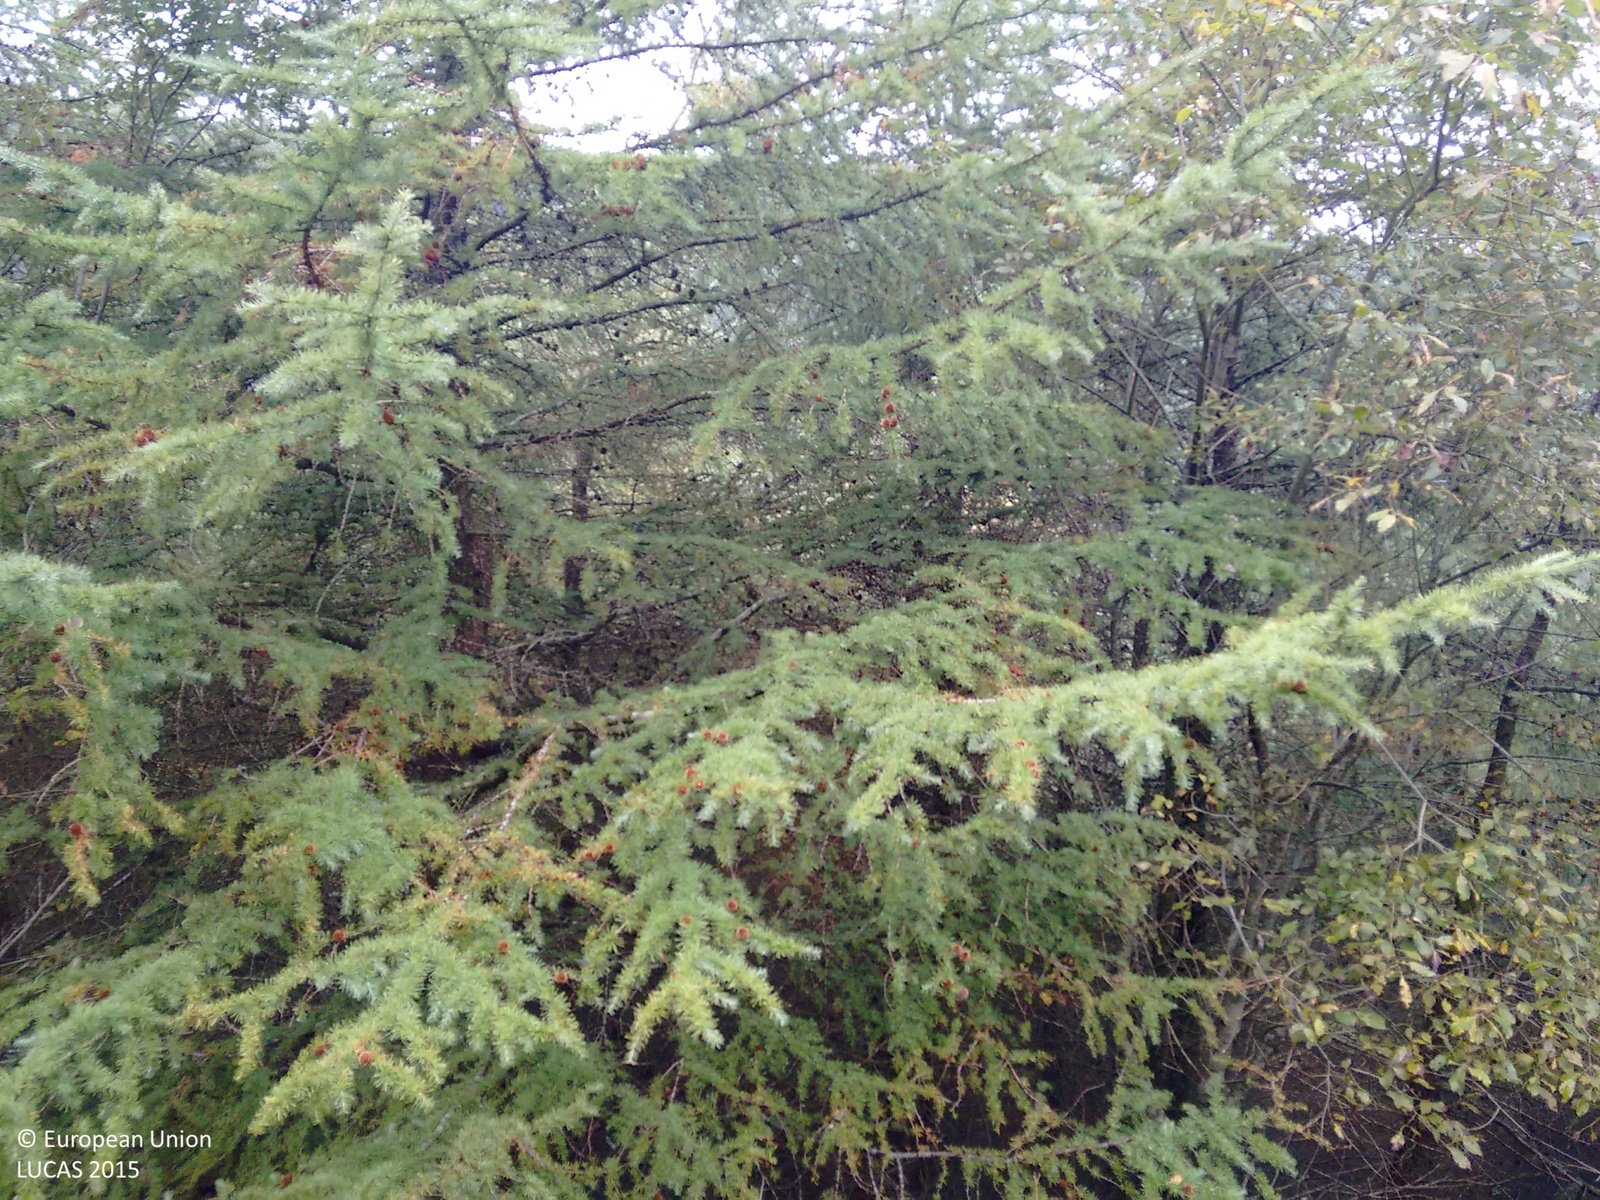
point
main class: Woodland
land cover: Pine dominated coniferous woodland
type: exotic forest
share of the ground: > 75 %
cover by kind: coniferous forest trees 80 %, shrubs 20 %
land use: Forestry
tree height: > 5 m
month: October
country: GB
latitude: 52.2779
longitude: -3.1667
